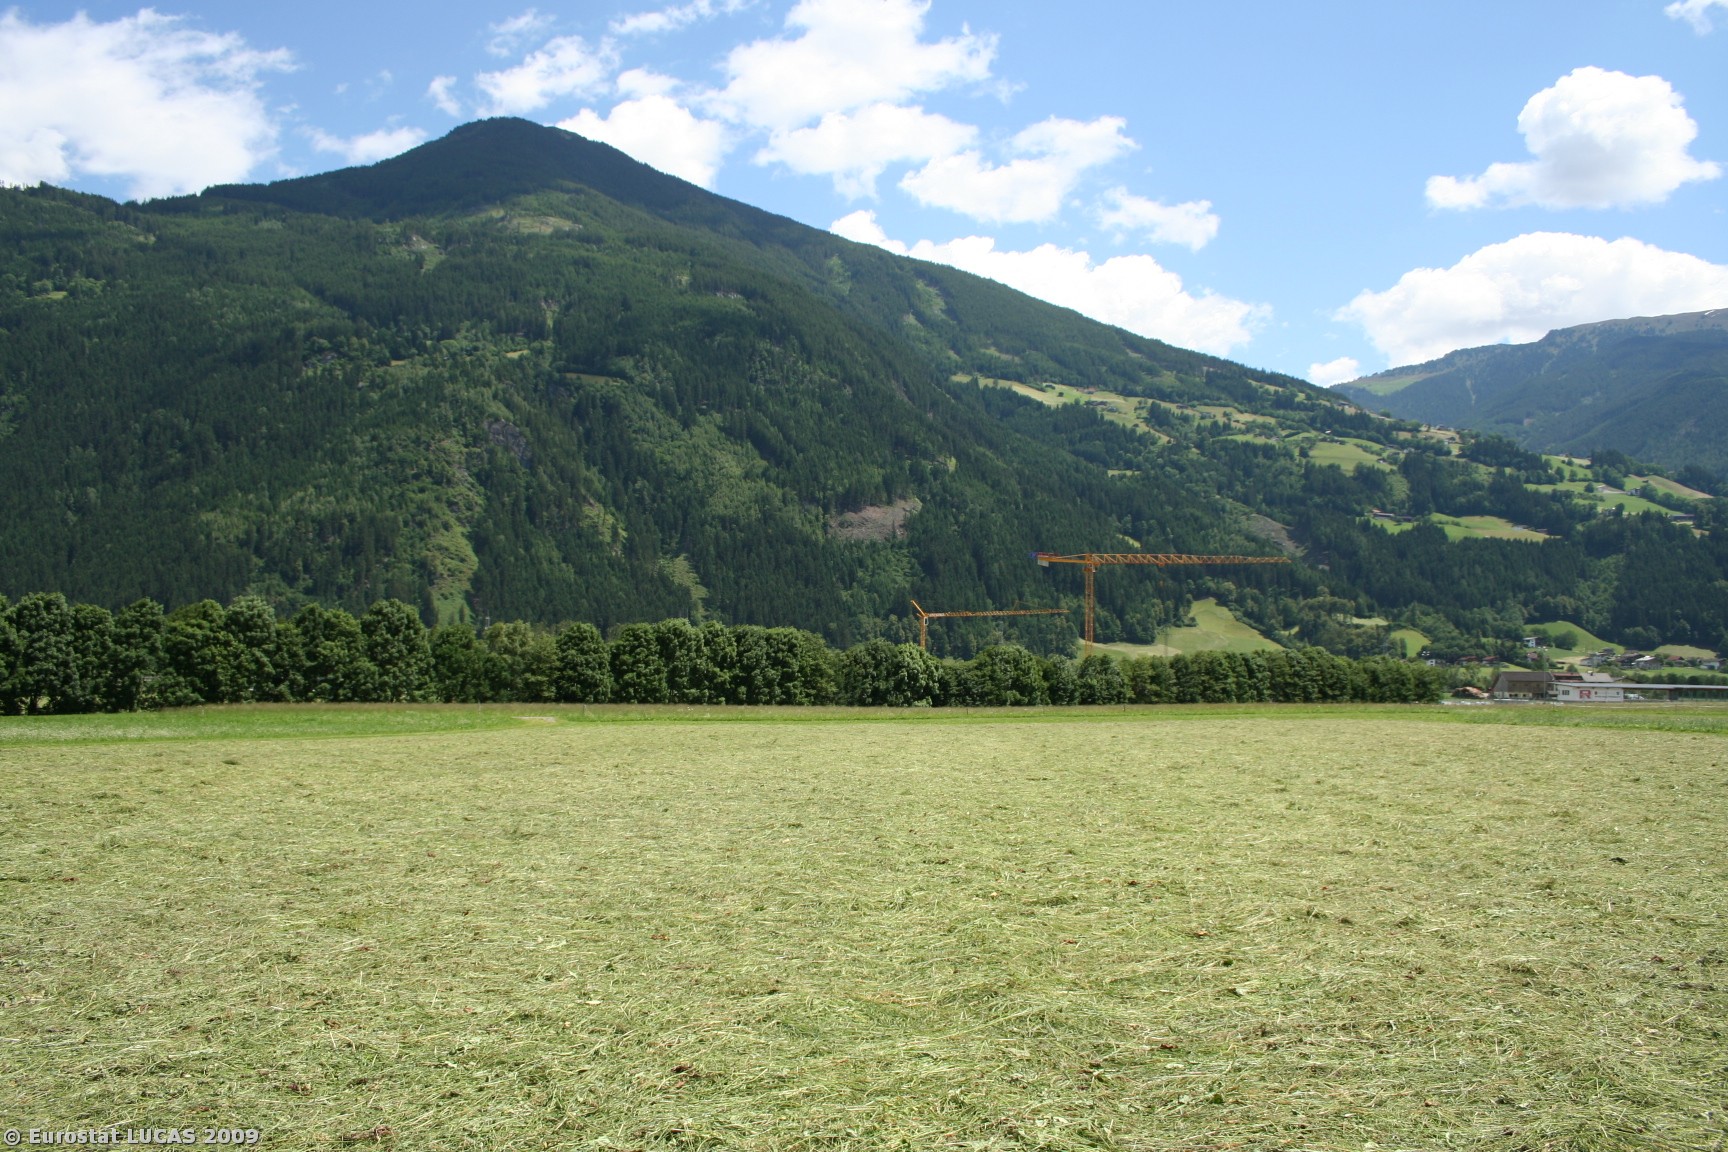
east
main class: Grassland
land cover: Grassland without tree/shrub cover
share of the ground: > 75 %
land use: Agriculture (excluding fallow land and kitchen gardens)
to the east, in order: Grassland without tree/shrub cover; Paved roads, cycling and walking lanes; Grassland without tree/shrub cover
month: June
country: AT
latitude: 47.3076
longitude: 11.8635
